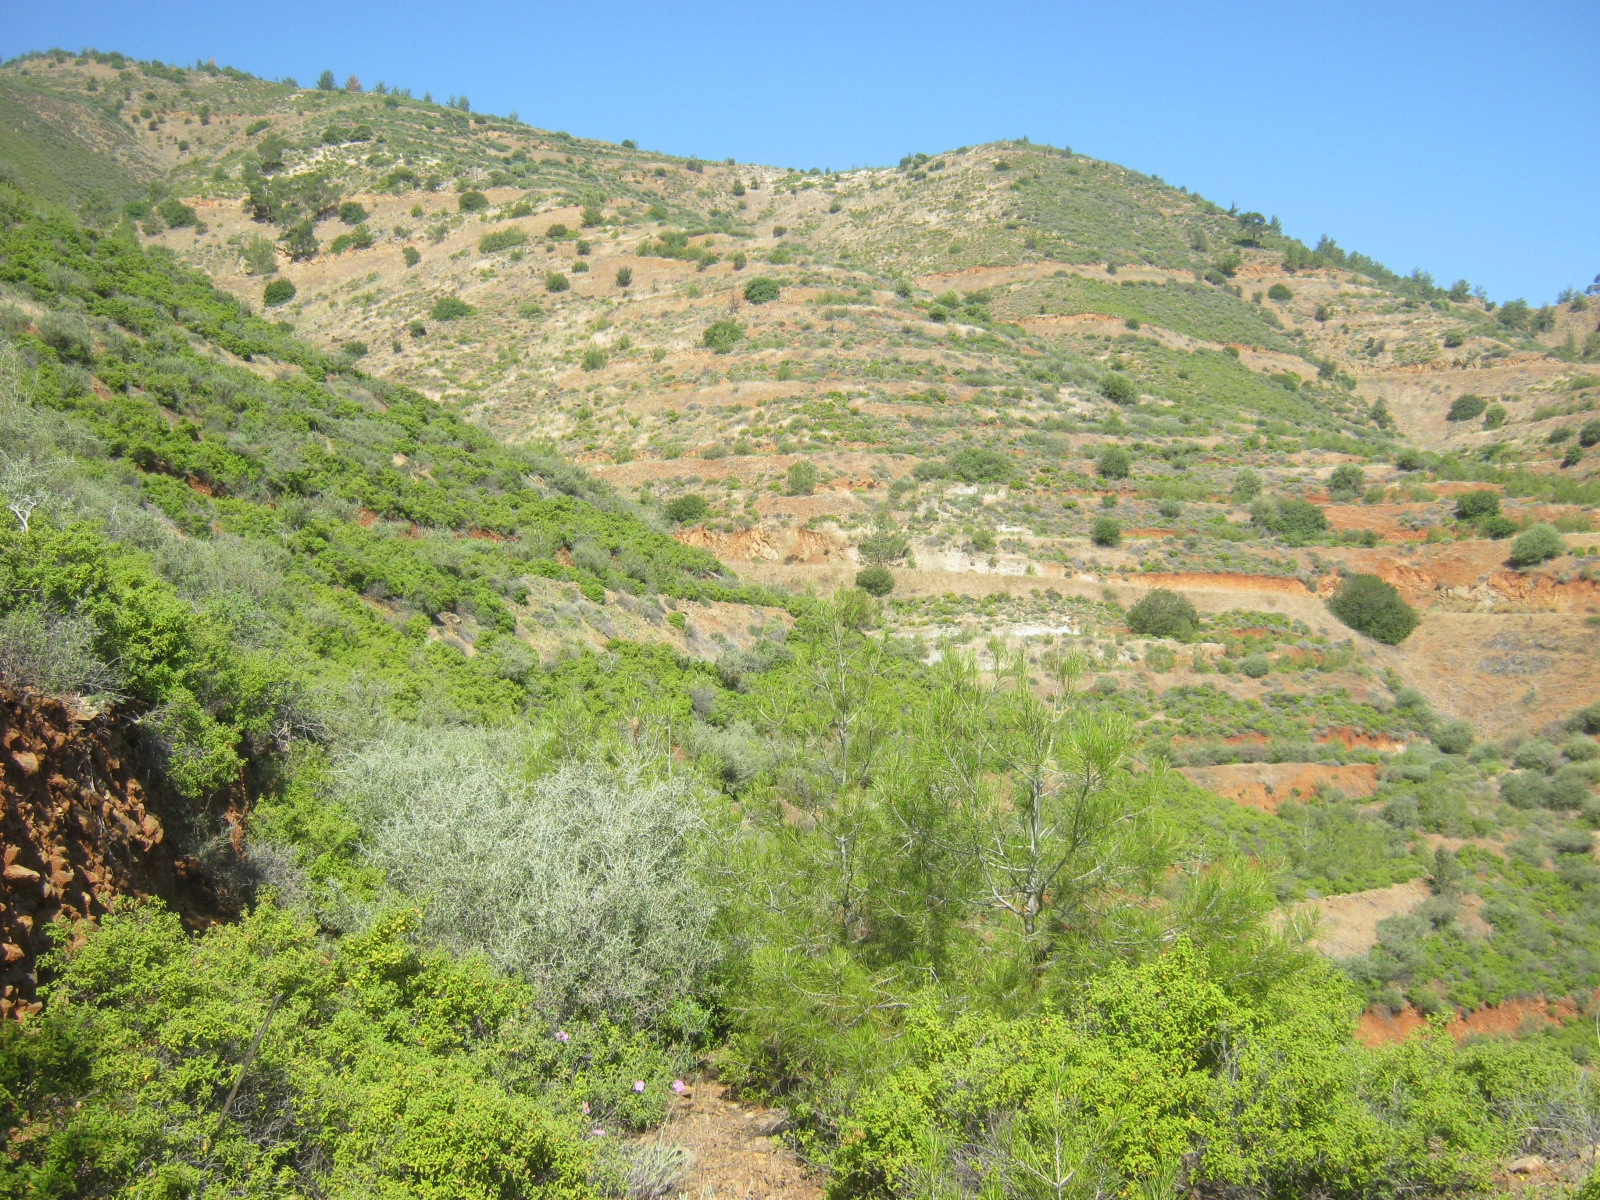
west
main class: Woodland
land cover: Pine dominated coniferous woodland
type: coniferous forest of the mediterranean region
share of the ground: 25 - 50 %
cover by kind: coniferous forest trees 40 %, shrubs 25 %, herbaceous plants 20 %, unconsolidated bare surface 15 %
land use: Forestry
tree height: < 5 m
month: May
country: CY
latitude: 35.0612
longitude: 32.8340
